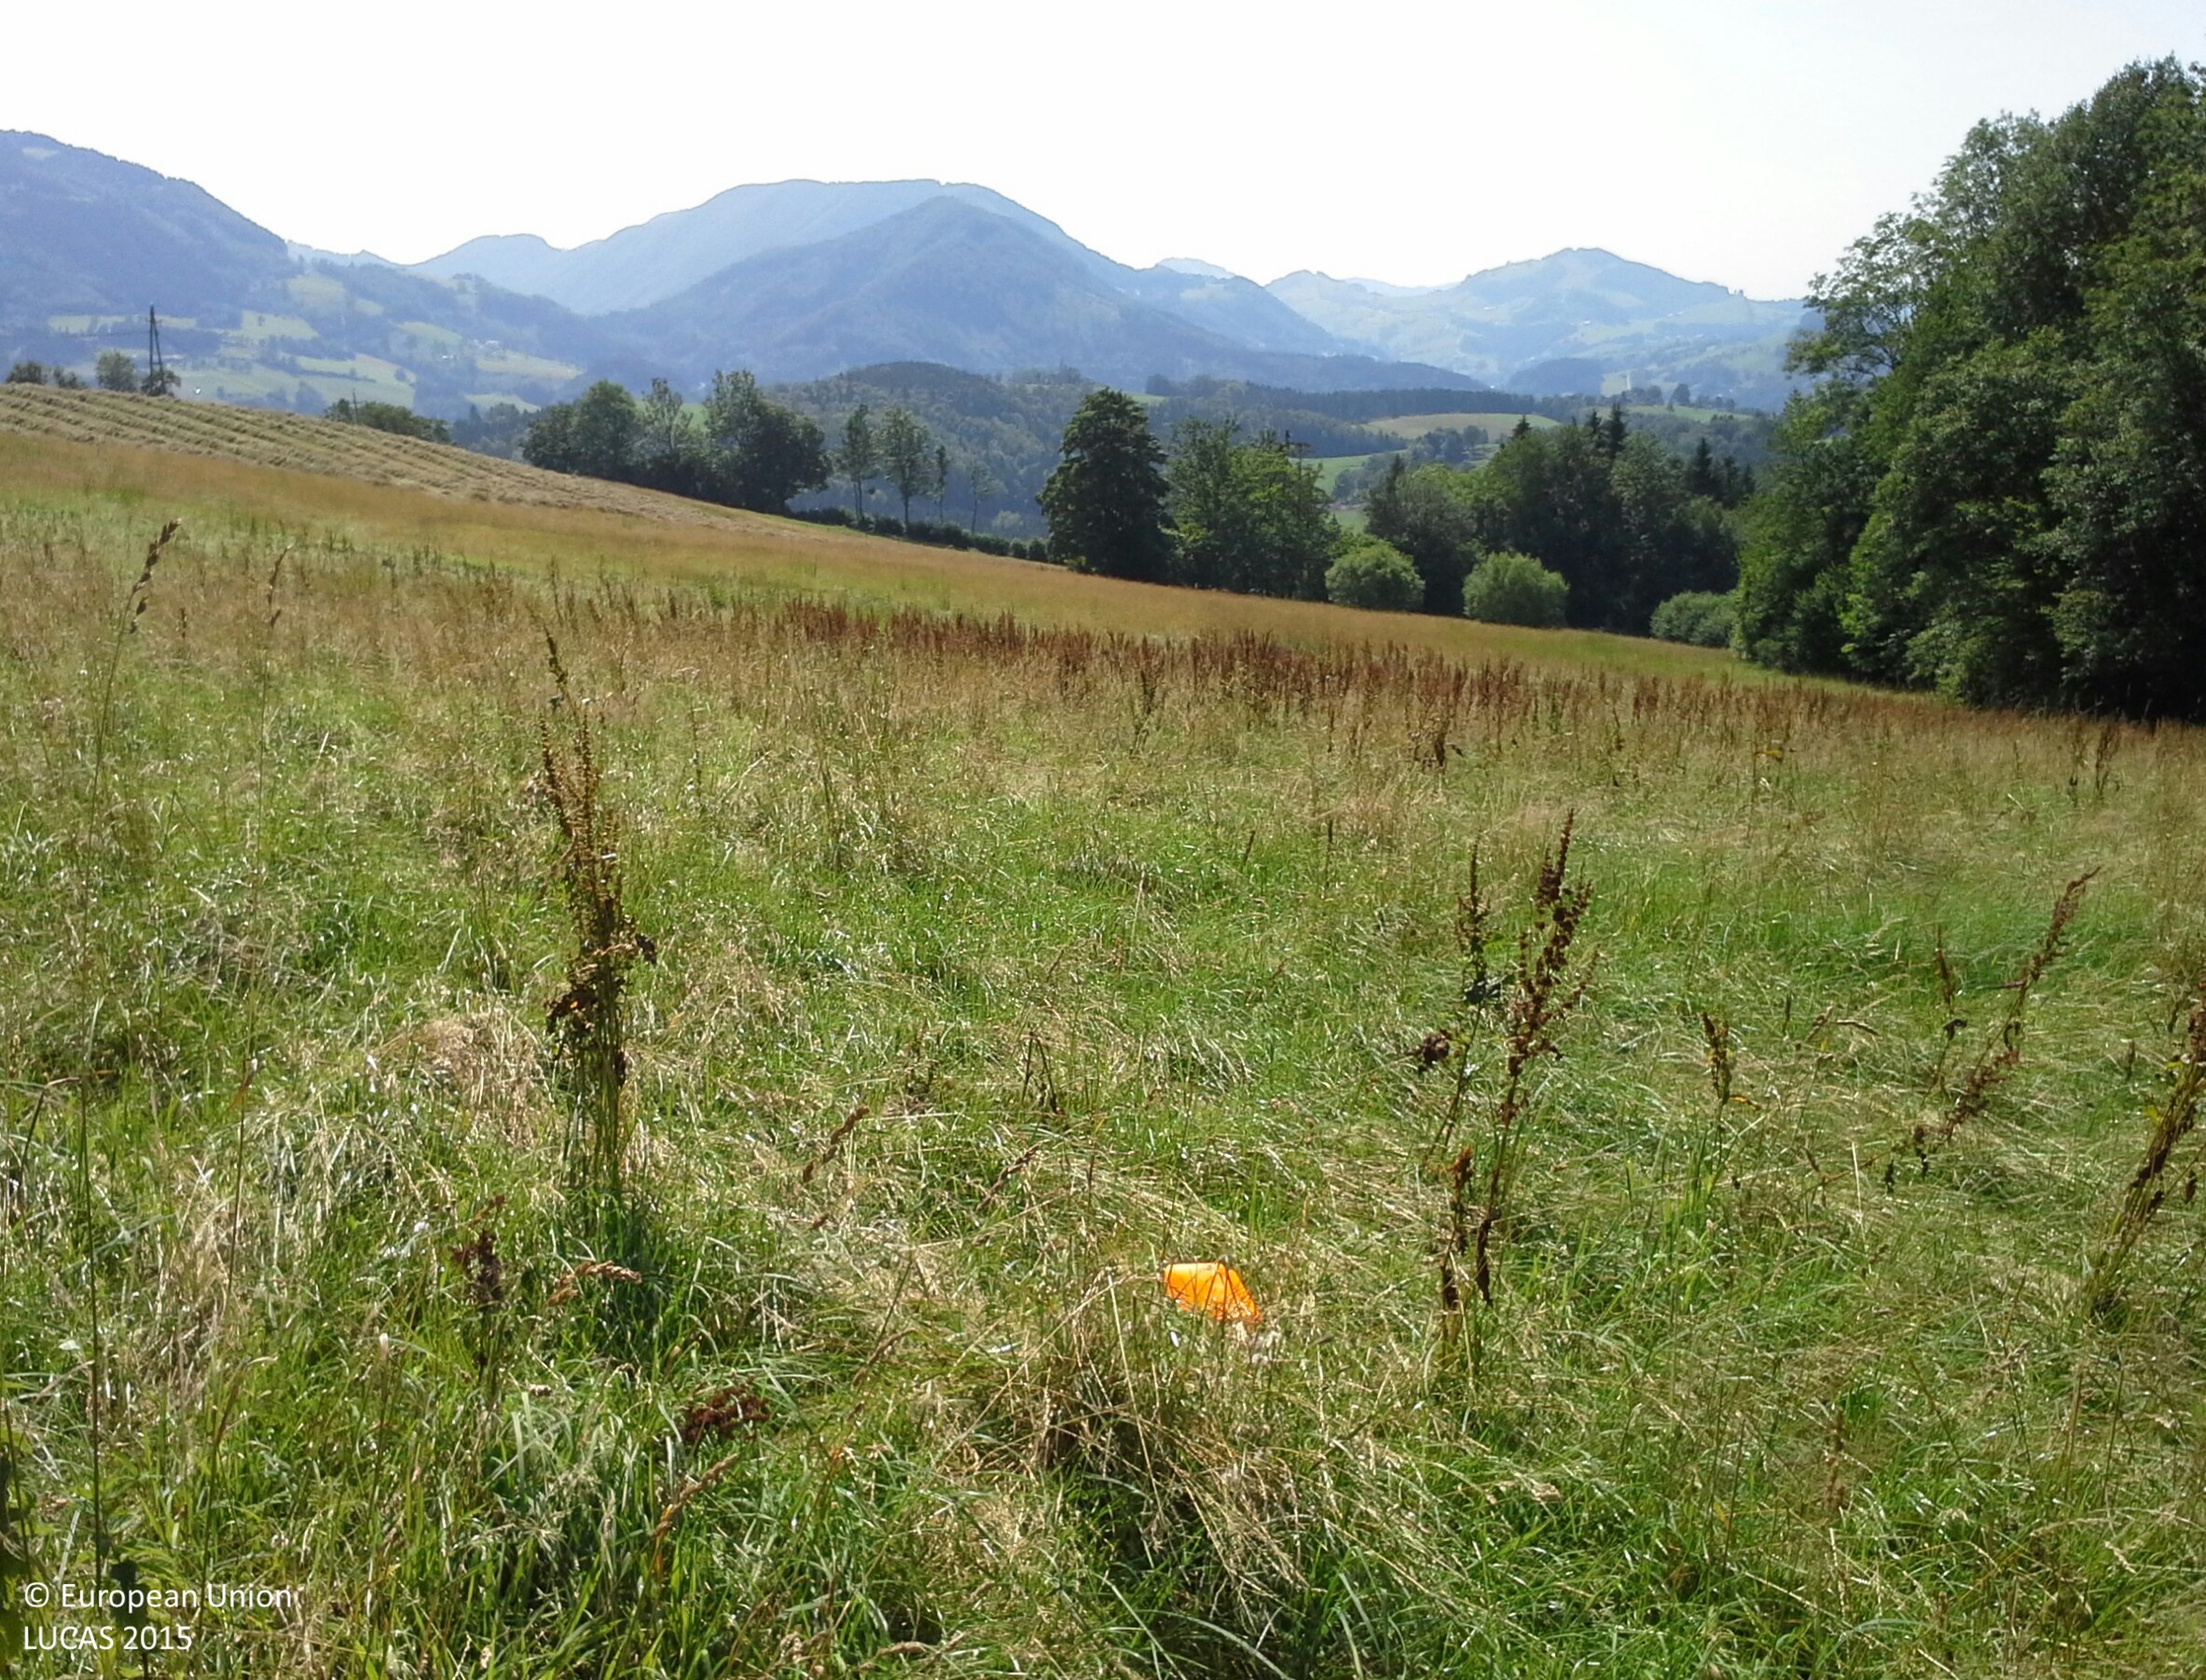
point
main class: Grassland
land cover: Grassland without tree/shrub cover
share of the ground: > 75 %
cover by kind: herbaceous plants 100 %
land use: Agriculture (excluding fallow land and kitchen gardens)
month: July
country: AT
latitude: 47.9553
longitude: 14.8346
